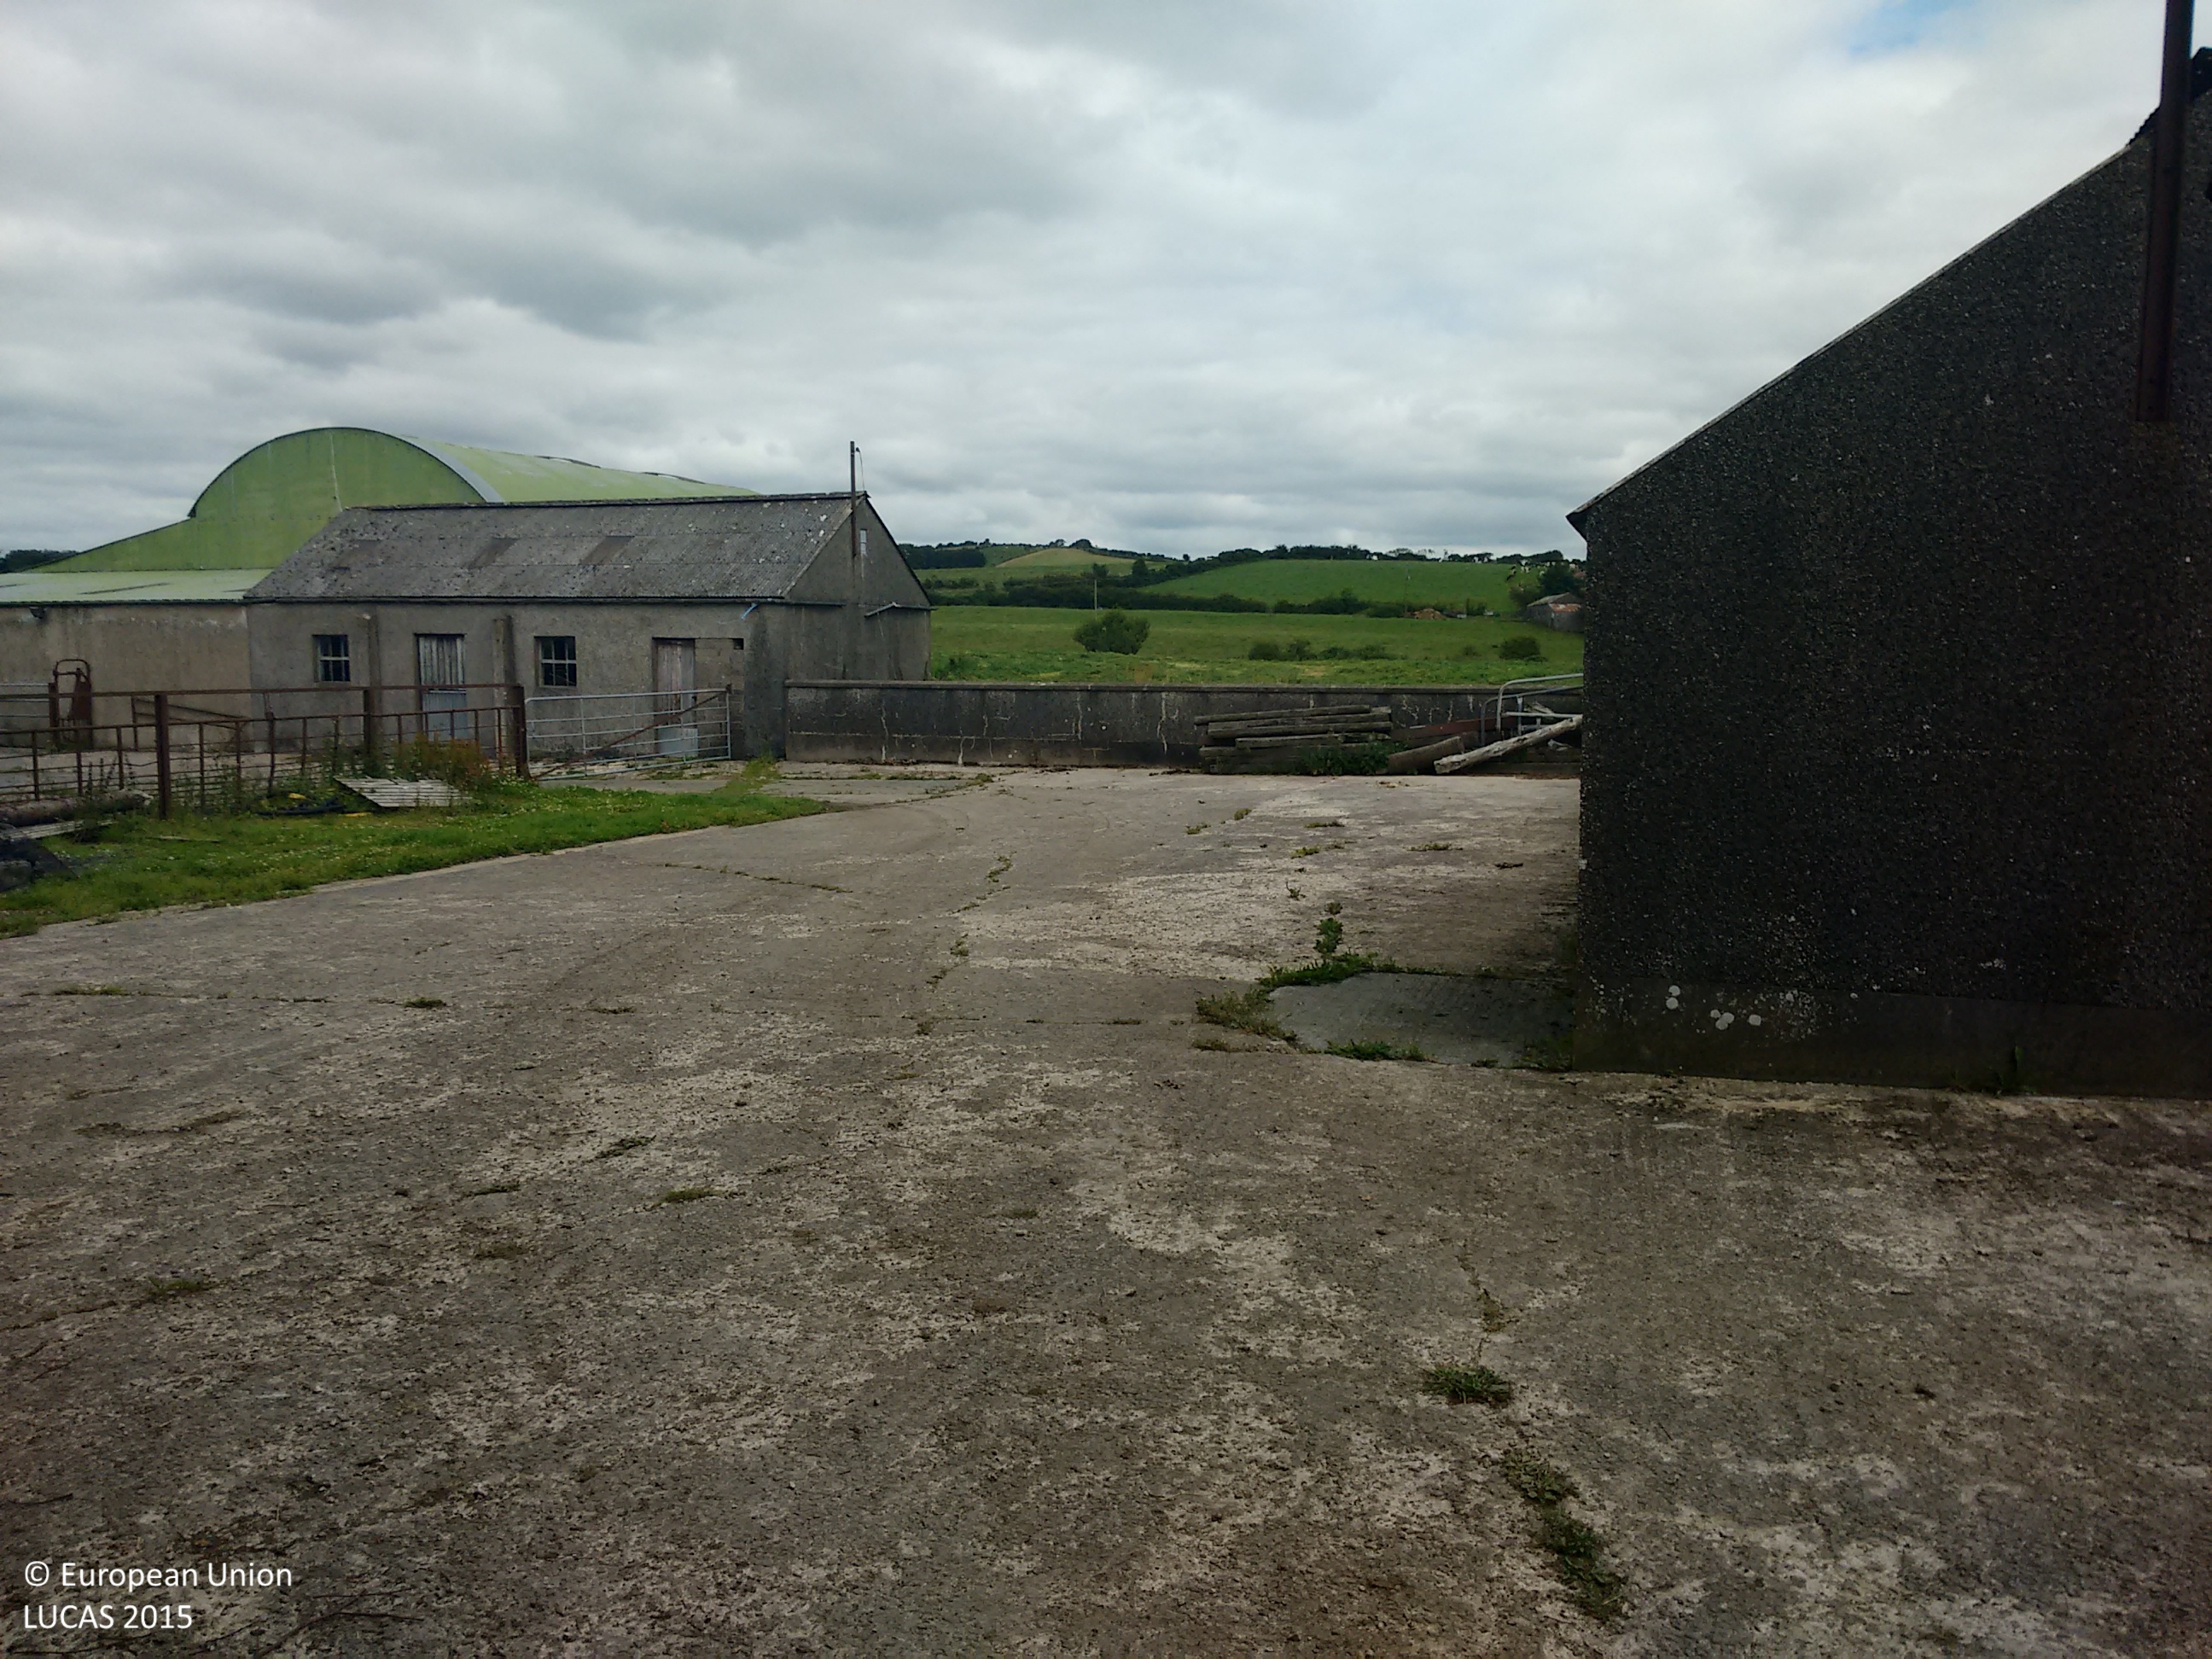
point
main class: Grassland
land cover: Grassland without tree/shrub cover
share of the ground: > 75 %
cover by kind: herbaceous plants 100 %
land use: Agriculture (excluding fallow land and kitchen gardens)
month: August
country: GB
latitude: 54.1712
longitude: -6.6271
